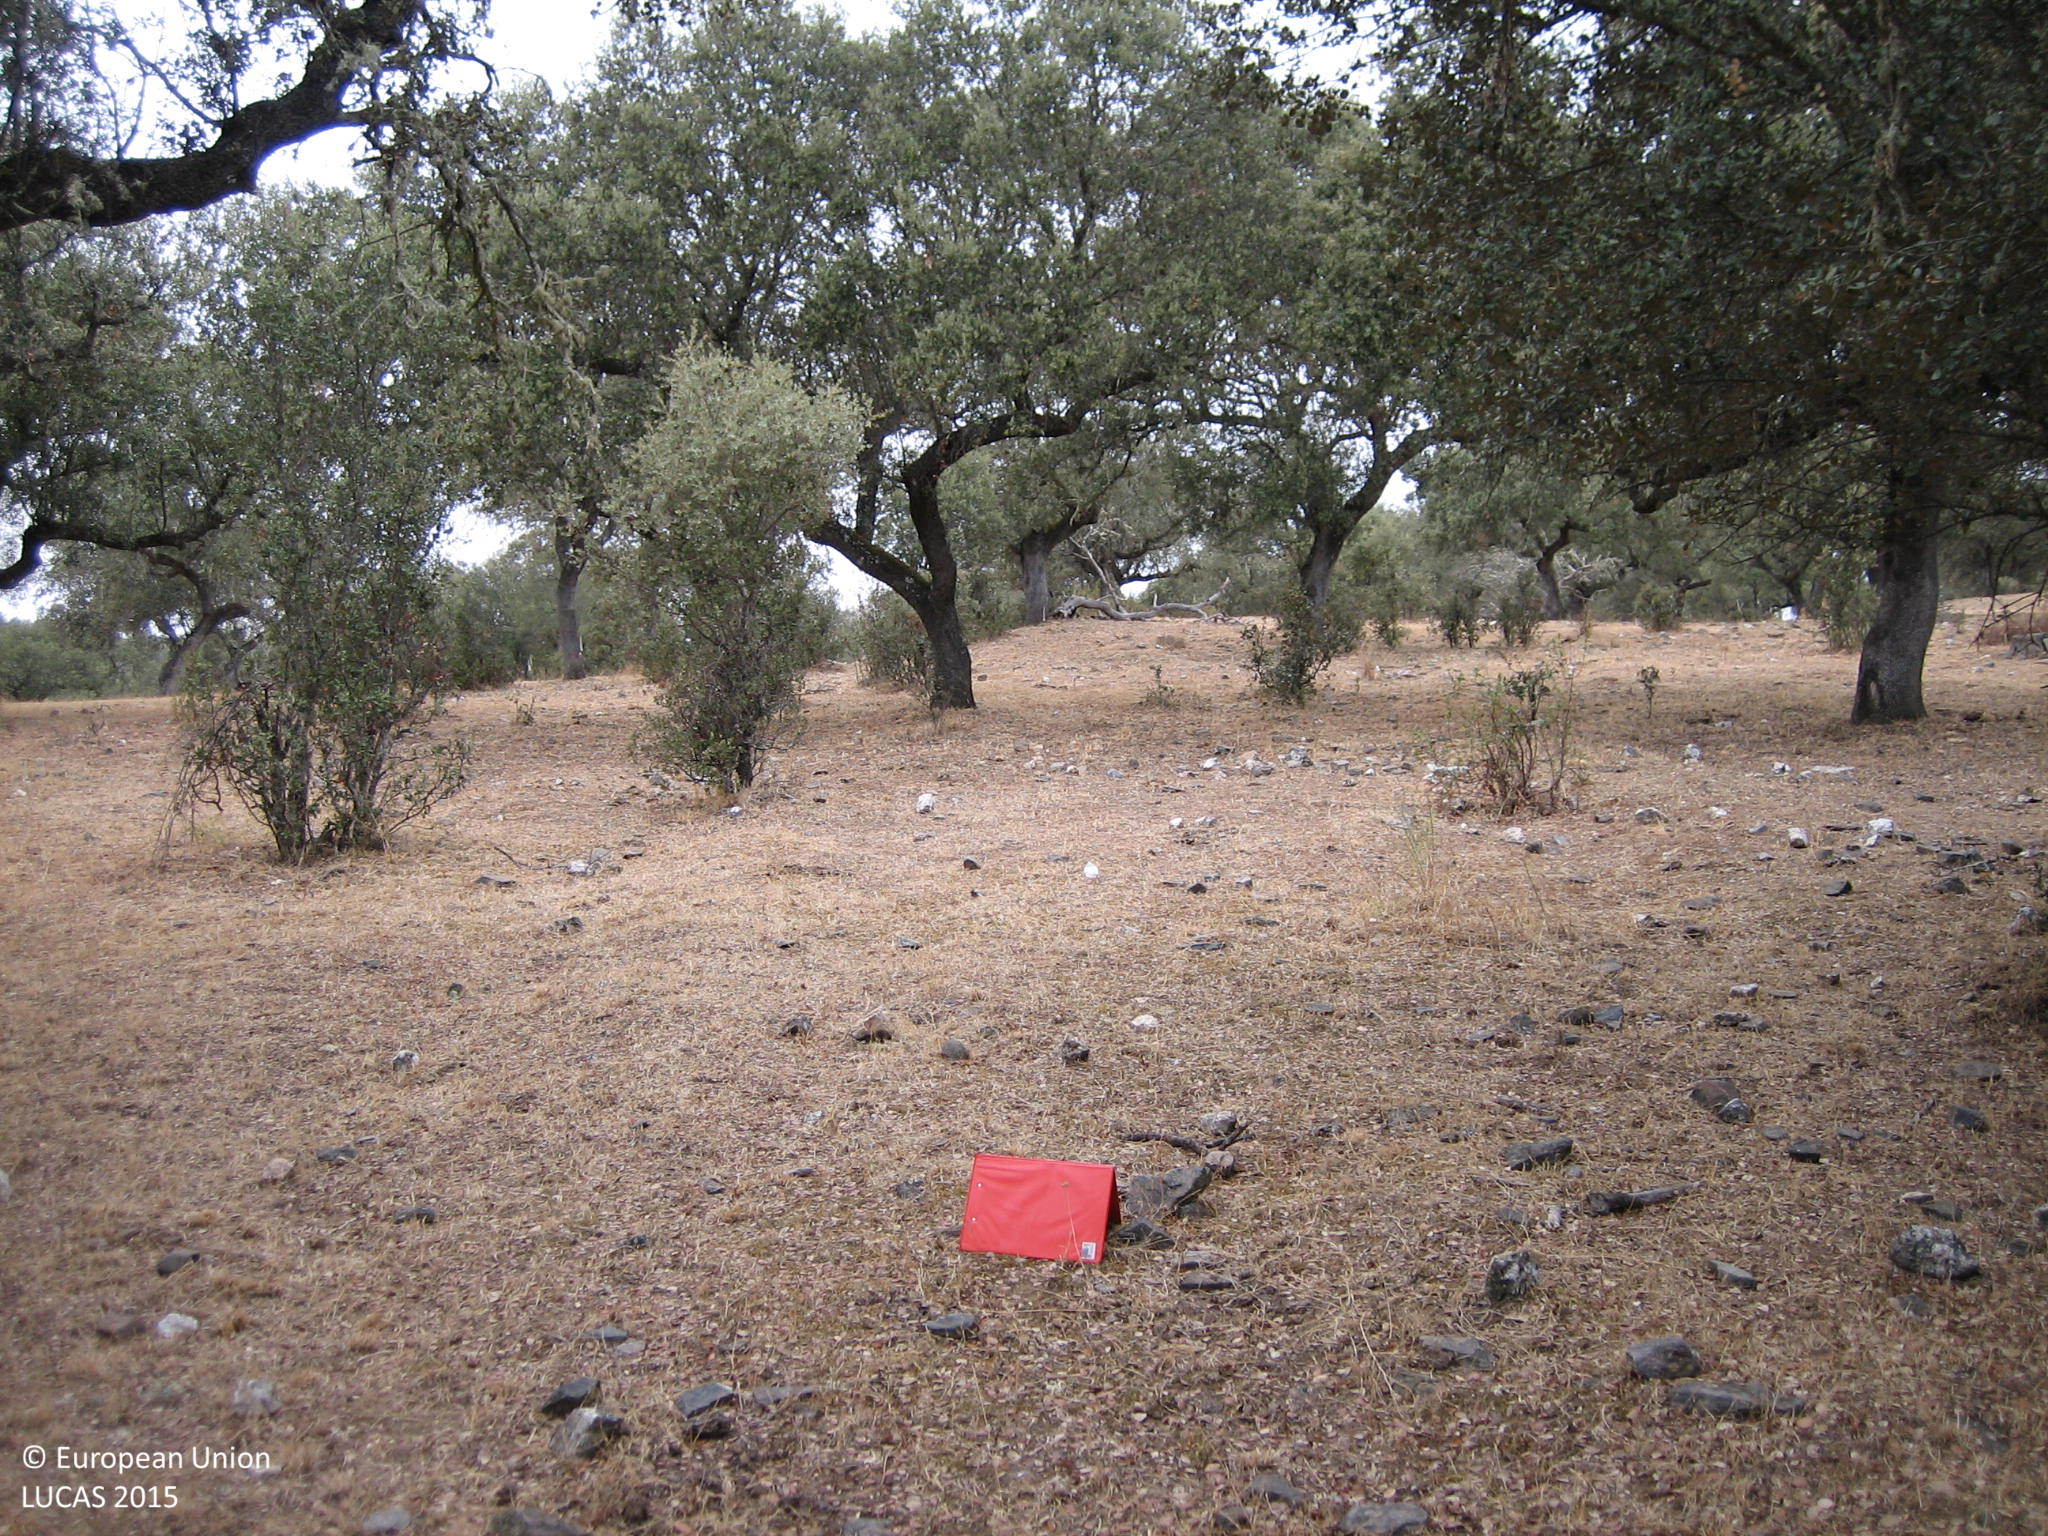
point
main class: Woodland
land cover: Broadleaved woodland
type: broadleaved evergreen forest
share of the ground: 25 - 50 %
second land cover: Grassland without tree/shrub cover
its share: 50 - 75 %
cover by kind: broadleaved forest trees 40 %, herbaceous plants 40 %, unconsolidated bare surface 15 %, shrubs 5 %
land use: Forestry
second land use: Agriculture (excluding fallow land and kitchen gardens)
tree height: > 5 m
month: September
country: ES
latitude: 38.2960
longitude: -7.1804
